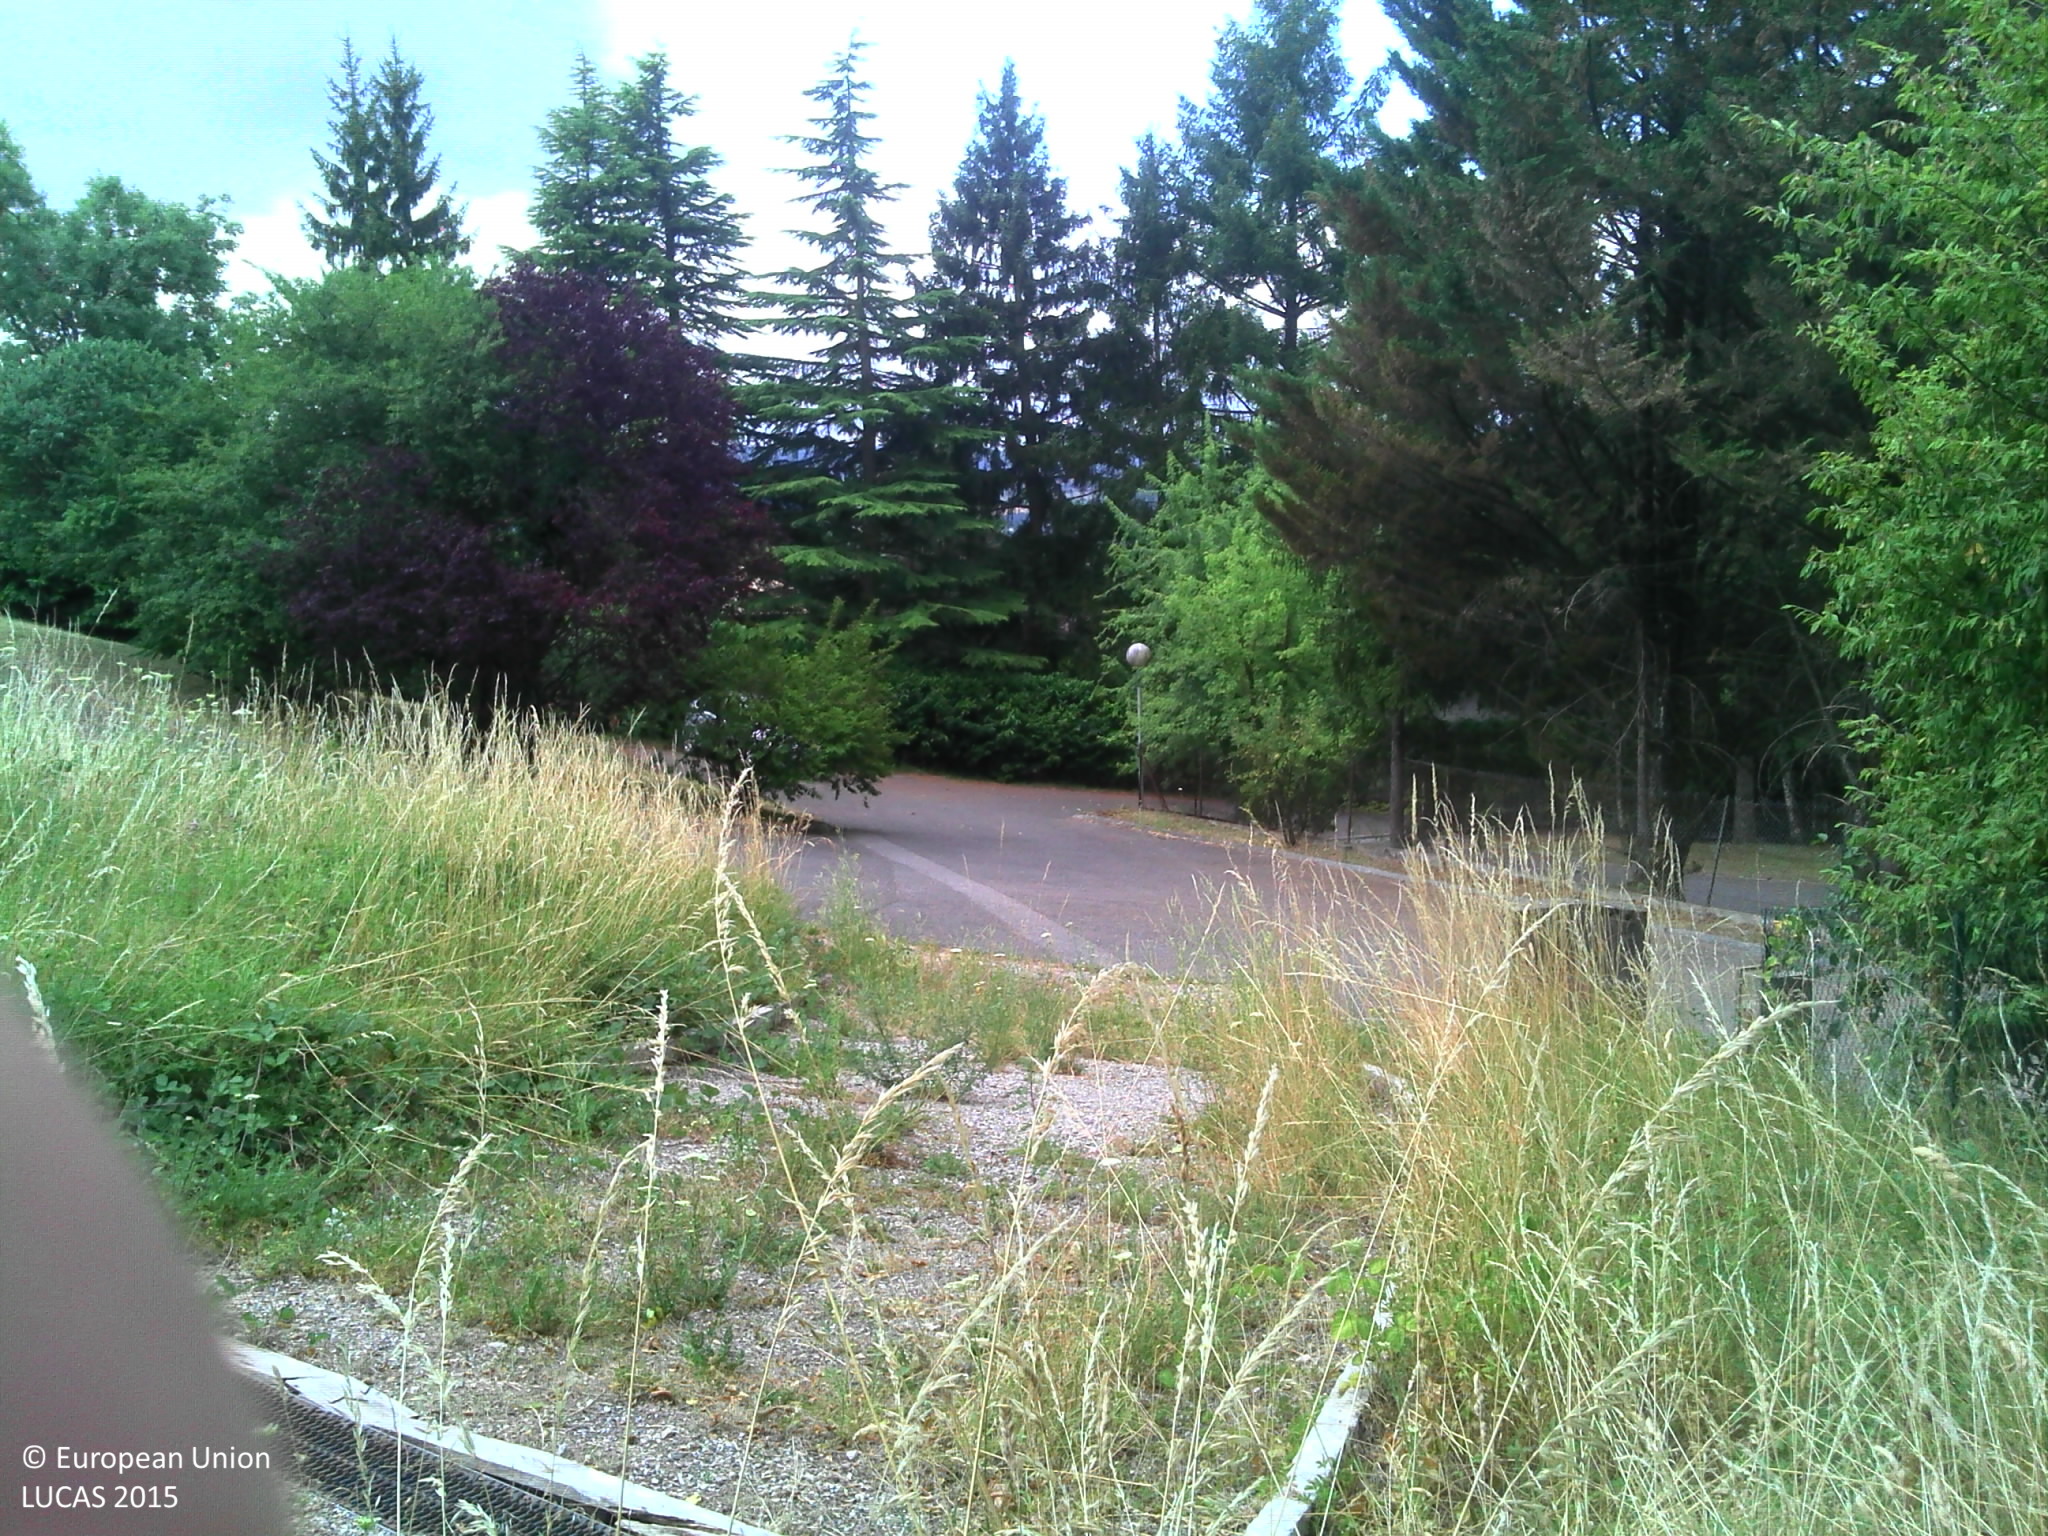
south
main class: Grassland
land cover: Grassland without tree/shrub cover
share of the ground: > 75 %
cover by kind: herbaceous plants 100 %
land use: Residential
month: July
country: FR
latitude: 46.1776
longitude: 6.2598
